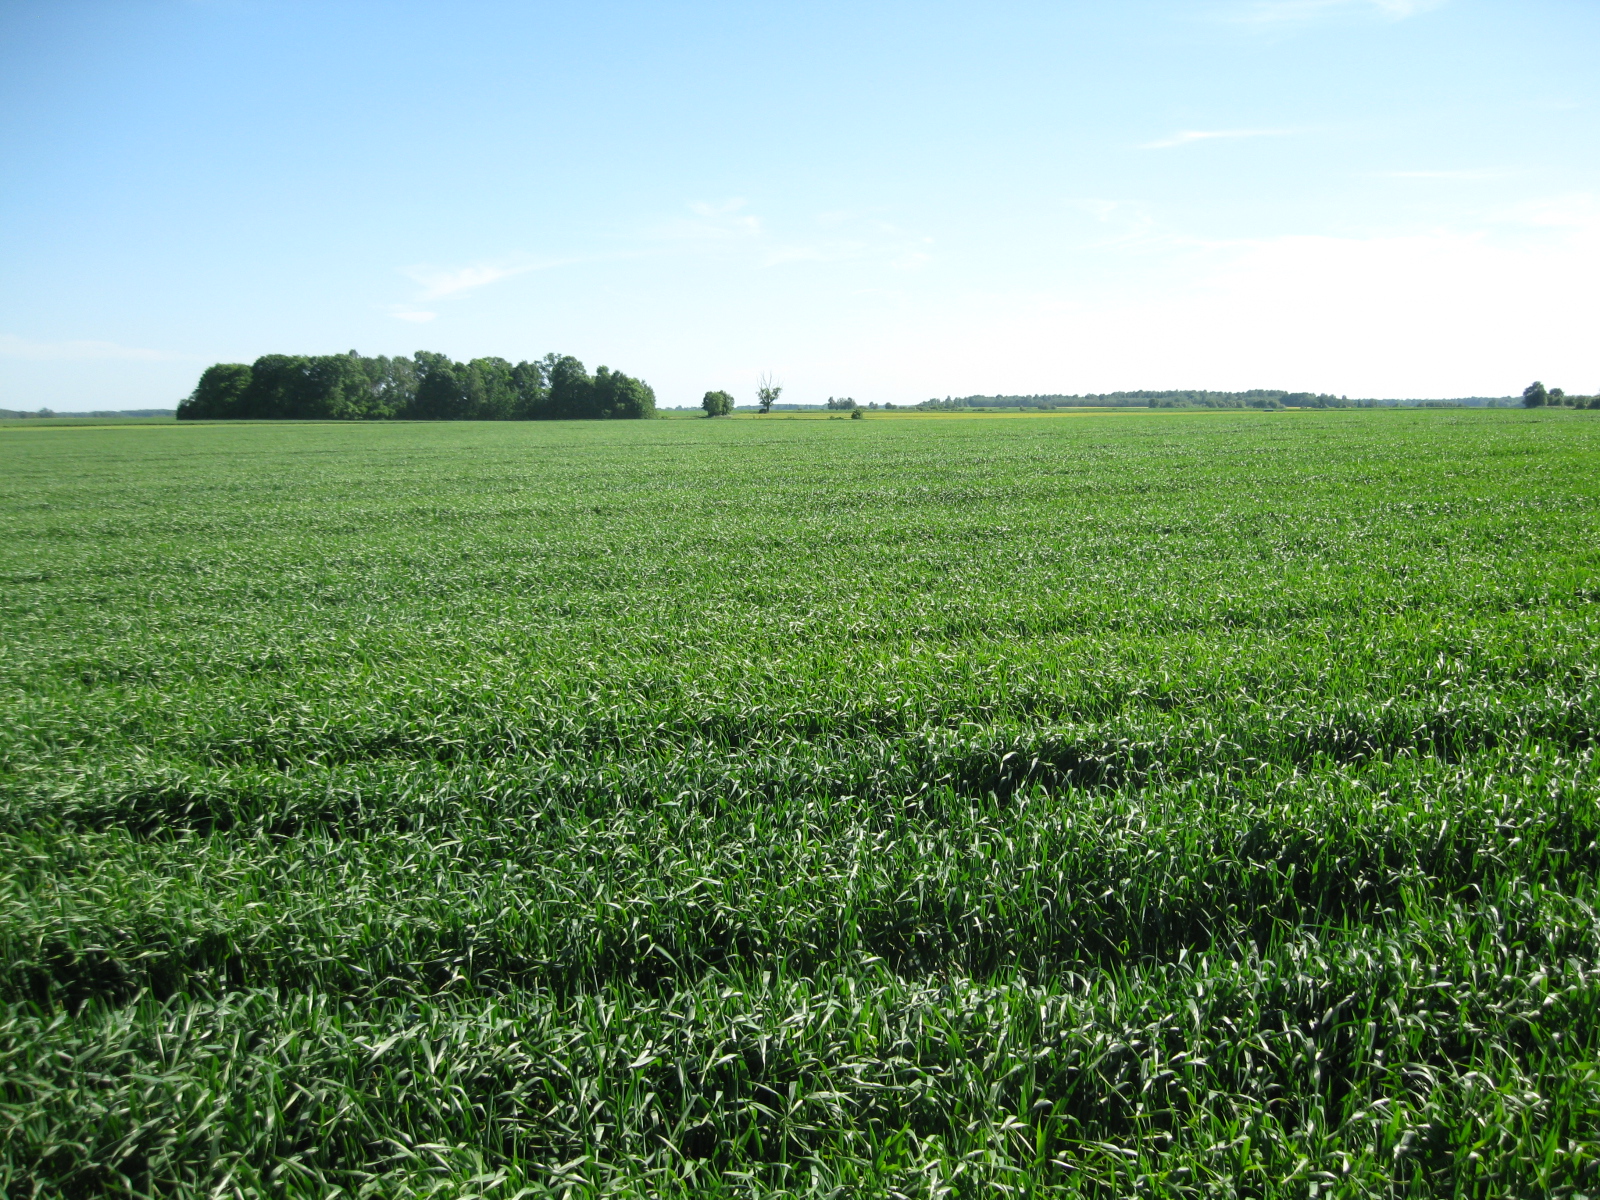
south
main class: Cropland
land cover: Common wheat
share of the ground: > 75 %
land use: Agriculture (excluding fallow land and kitchen gardens)
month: June
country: LT
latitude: 55.8323
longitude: 23.8634
